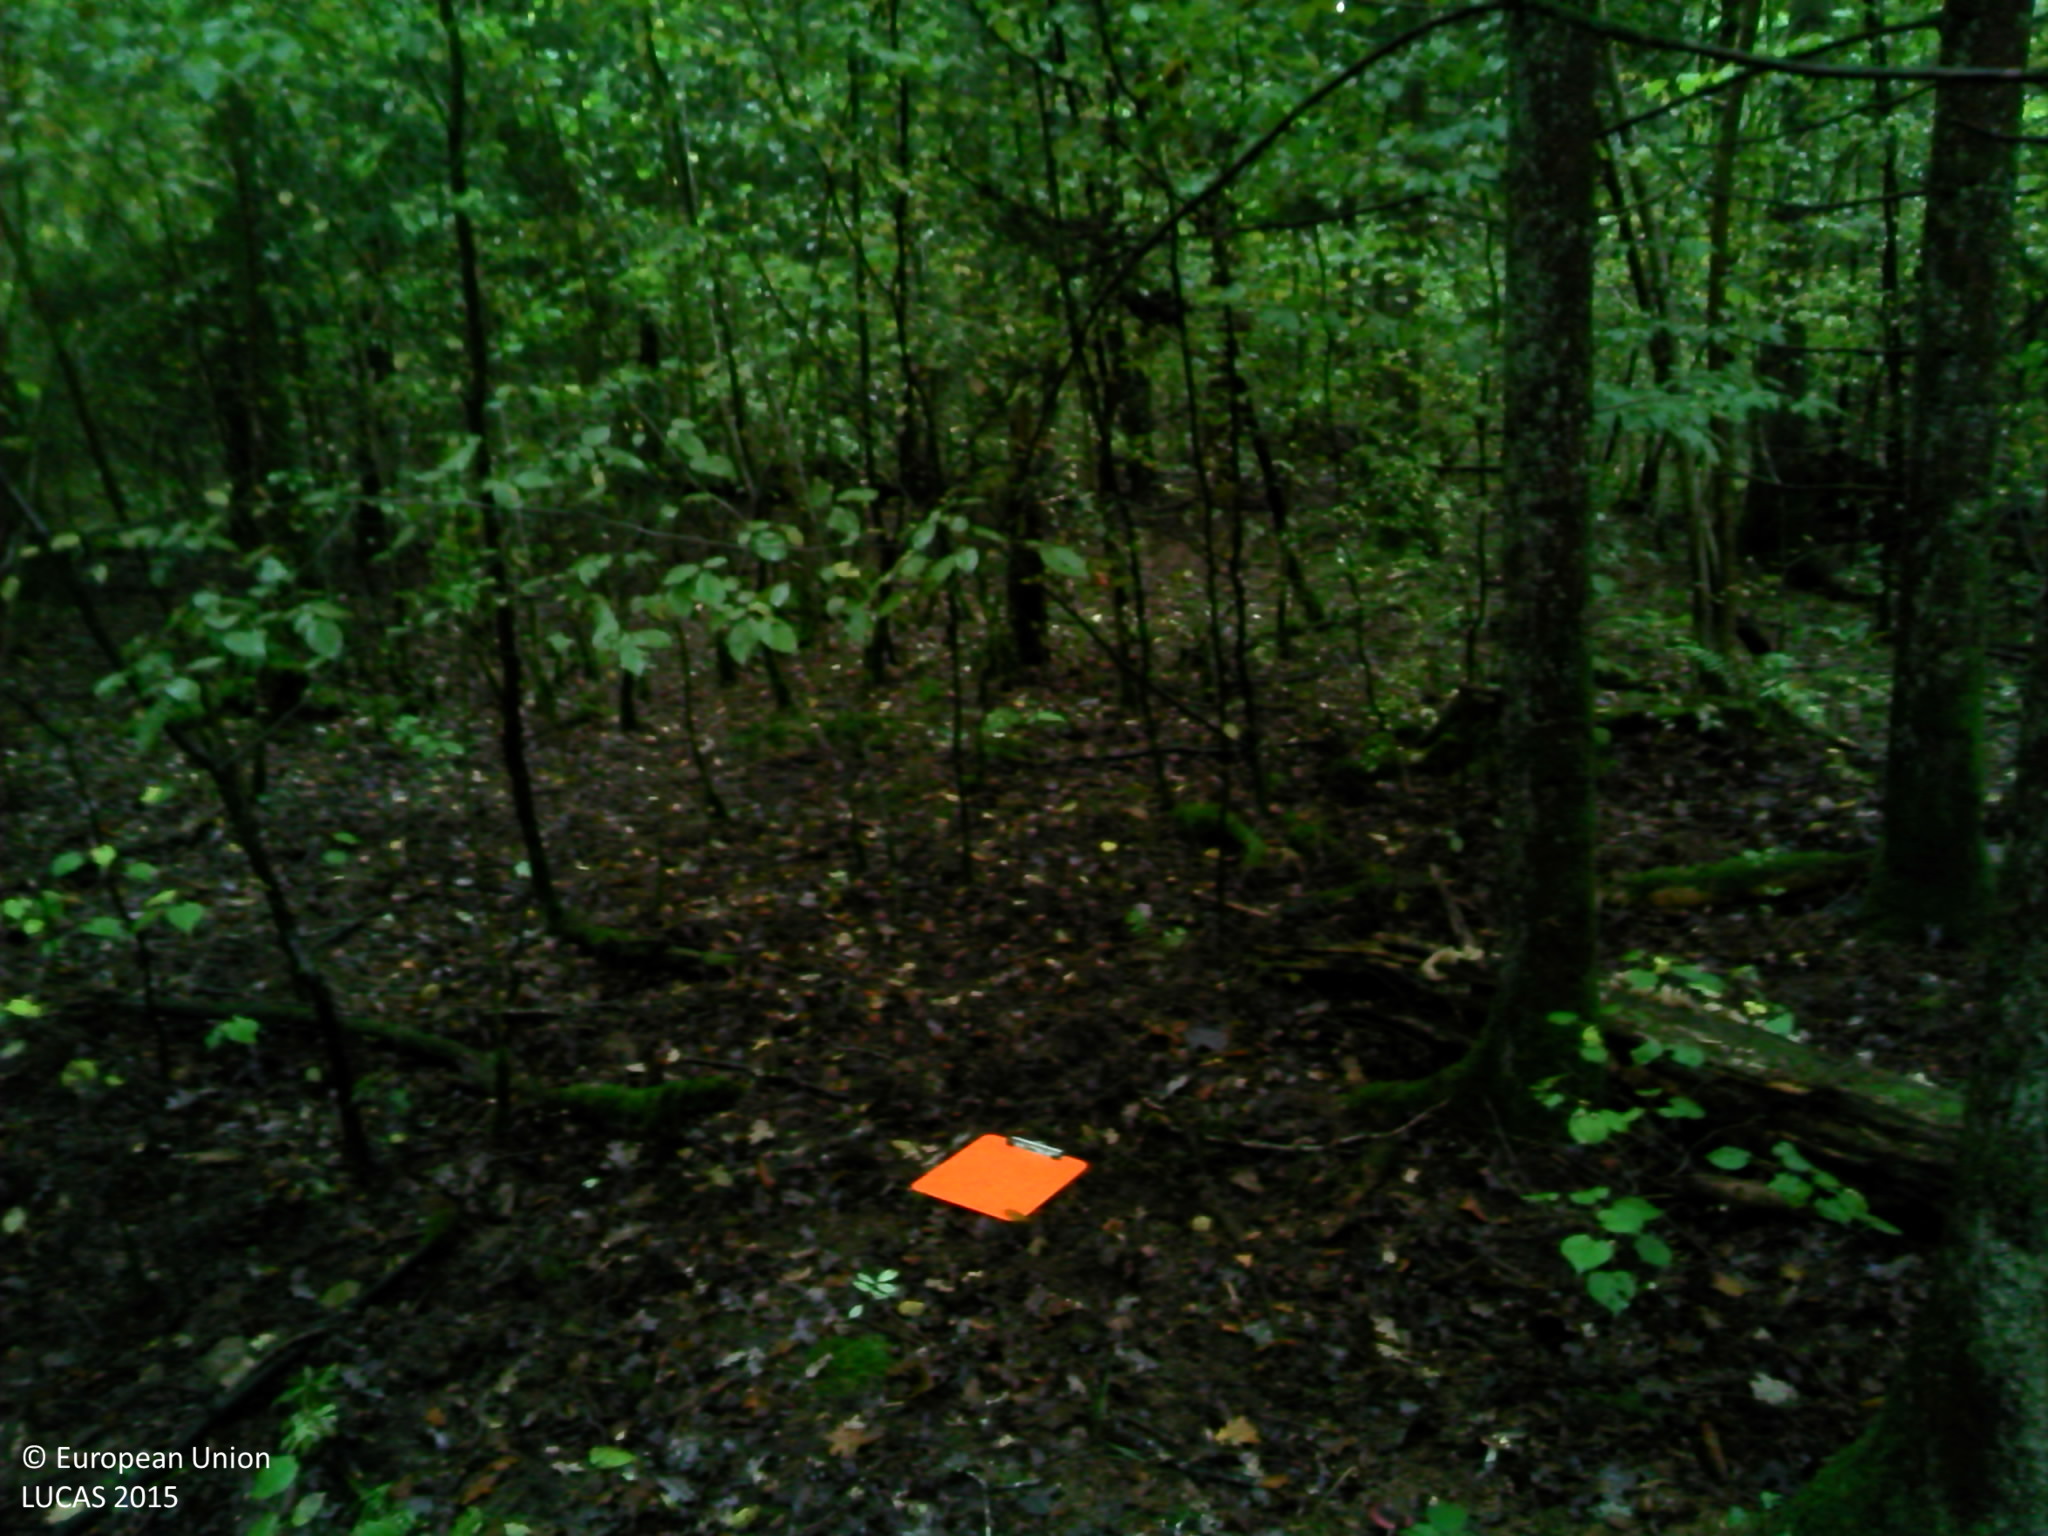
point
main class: Woodland
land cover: Spruce dominated mixed woodland
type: hemiboreal forest and nemoral coniferous forest and mixed broadleaved-coniferous forest
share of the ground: > 75 %
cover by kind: broadleaved forest trees 75 %, coniferous forest trees 25 %
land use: Forestry
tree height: > 5 m
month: October
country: FR
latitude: 48.2027
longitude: 4.3056
